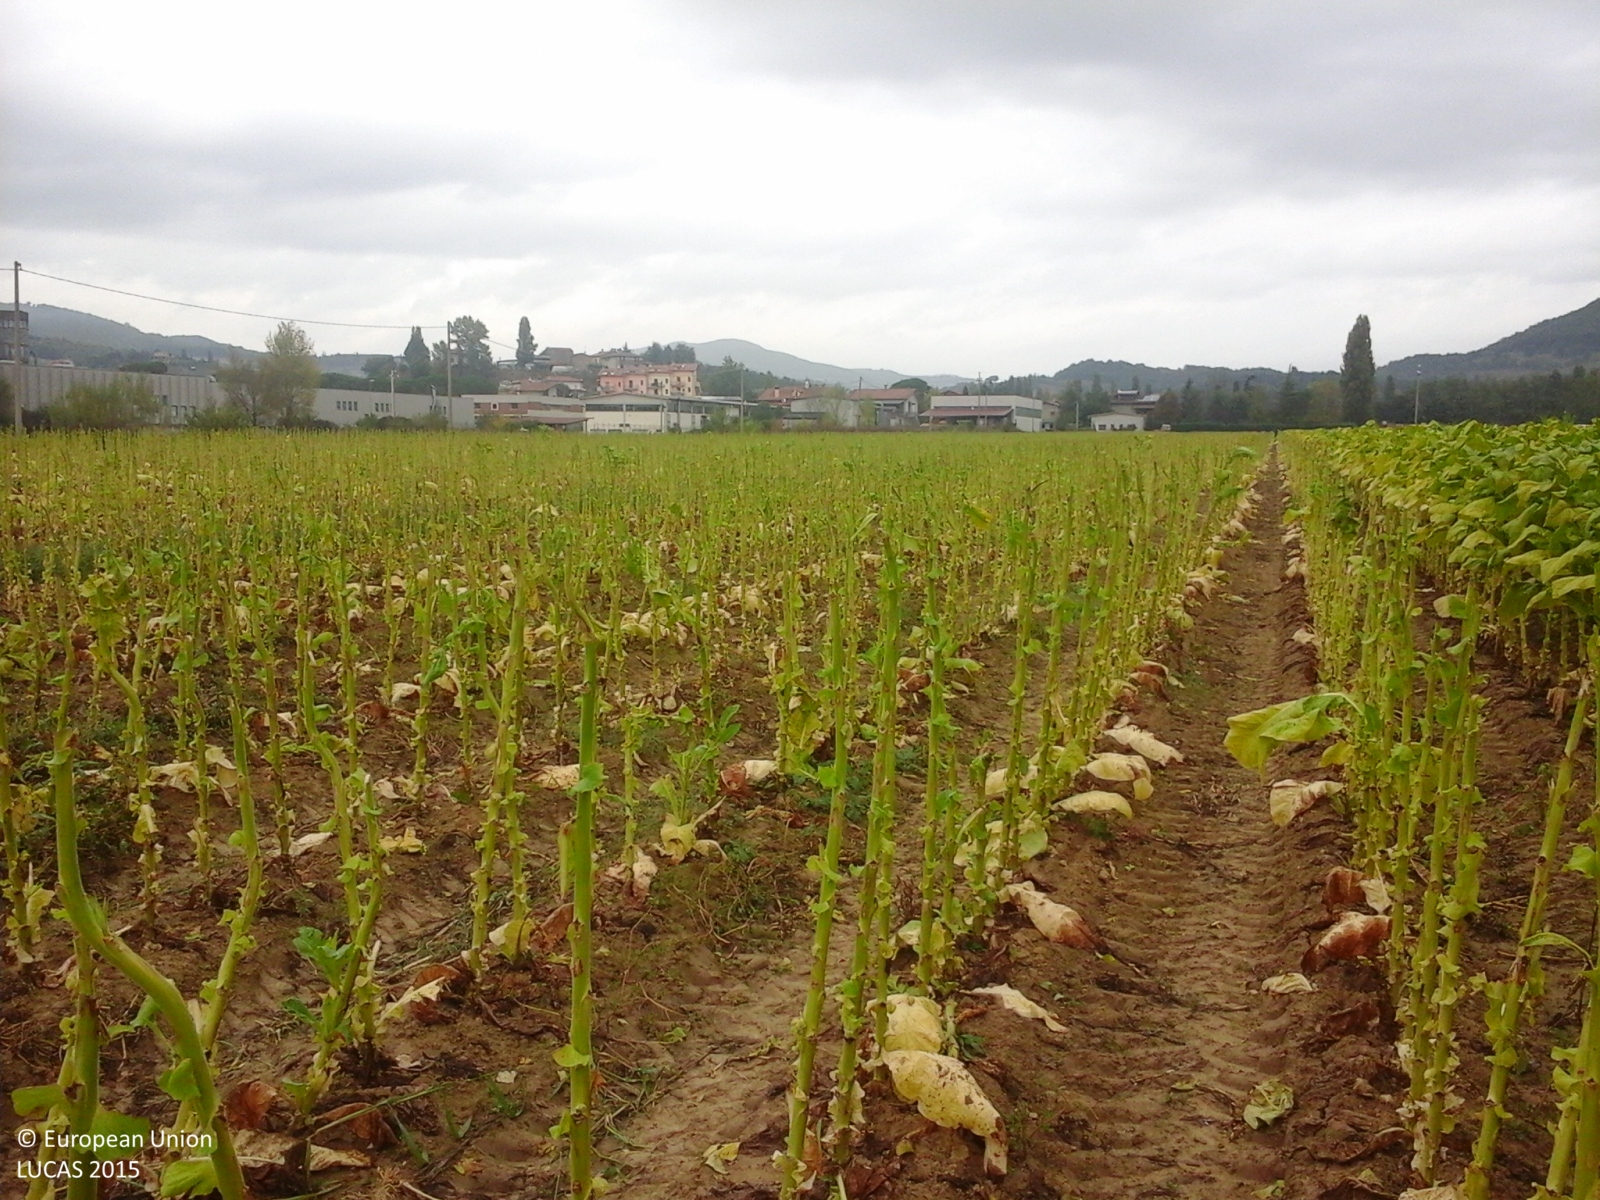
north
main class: Cropland
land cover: Tobacco
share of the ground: > 75 %
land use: Agriculture (excluding fallow land and kitchen gardens)
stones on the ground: < 10 %
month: October
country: IT
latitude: 43.3706
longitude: 12.2030
